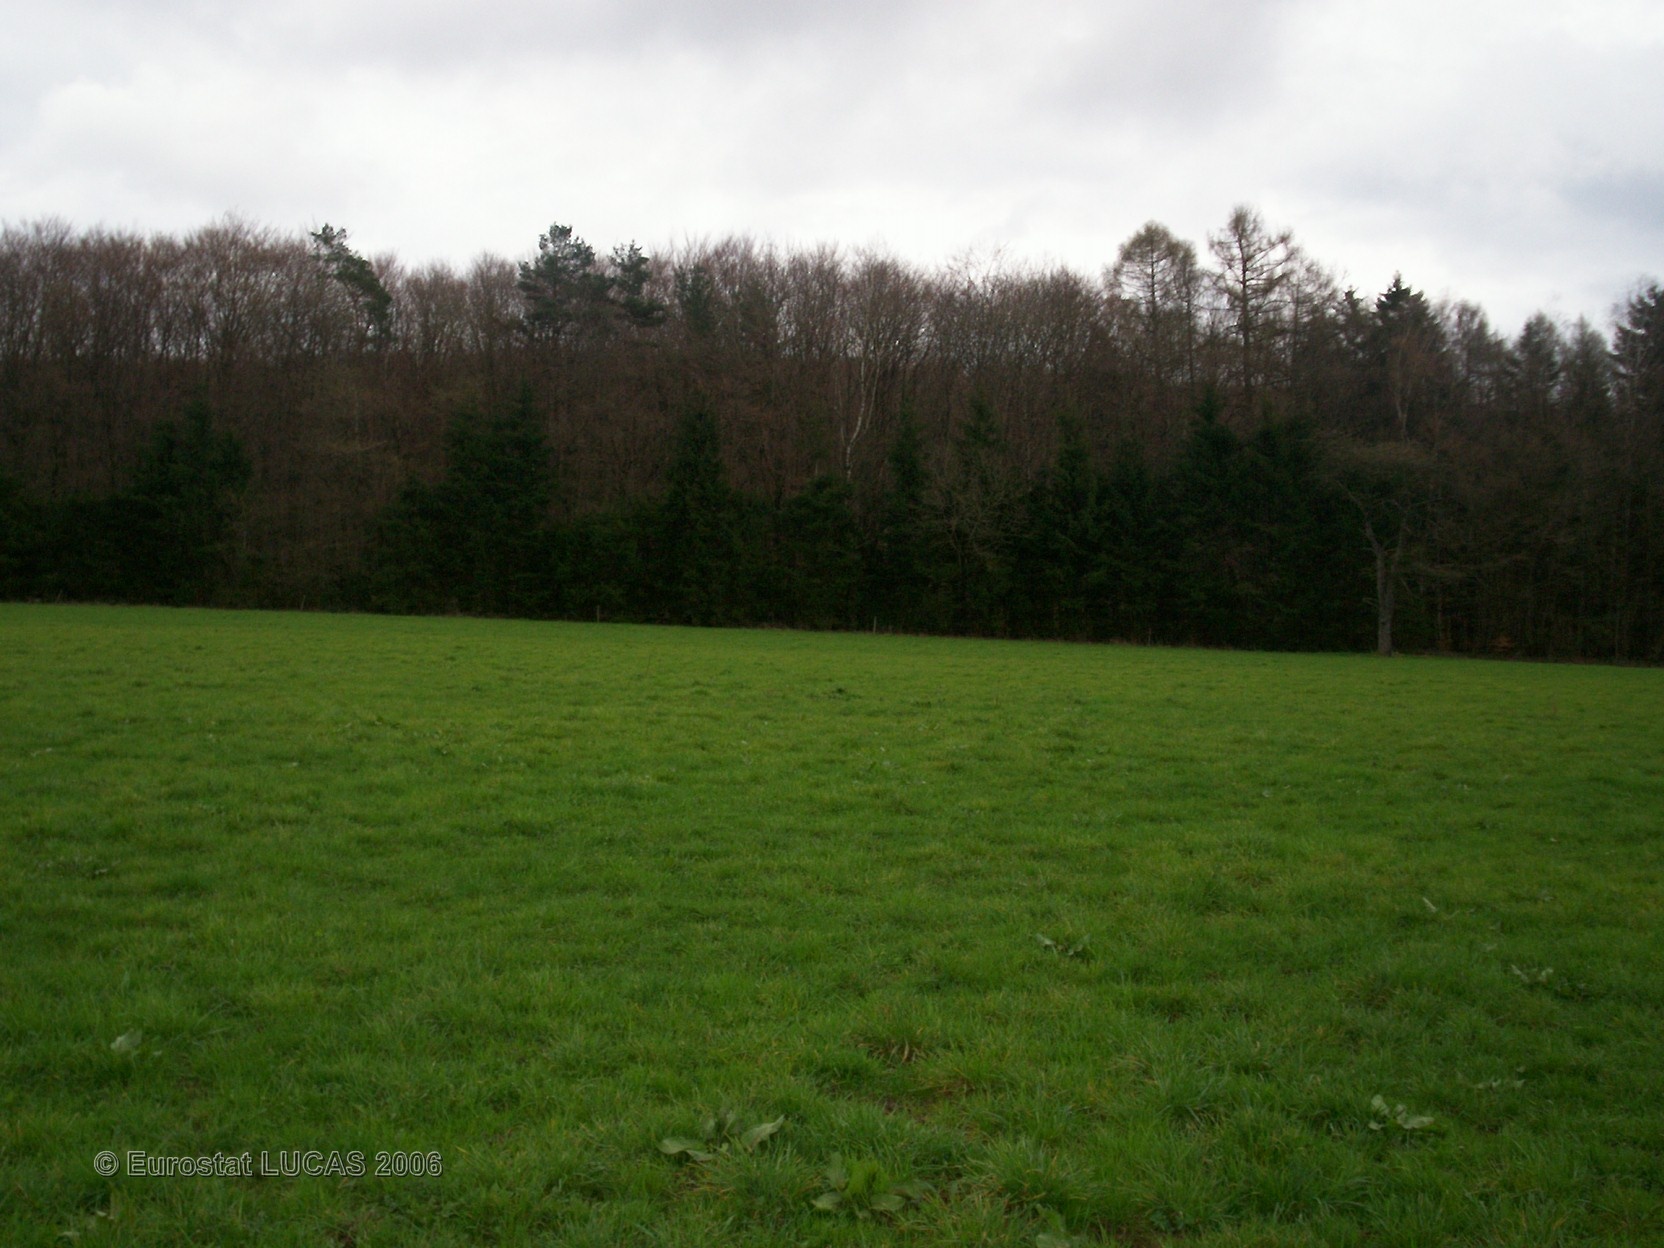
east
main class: Grassland
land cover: Grassland without tree/shrub cover
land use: Agriculture (excluding fallow land and kitchen gardens)
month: April
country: FR
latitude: 47.4880
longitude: 6.6438
